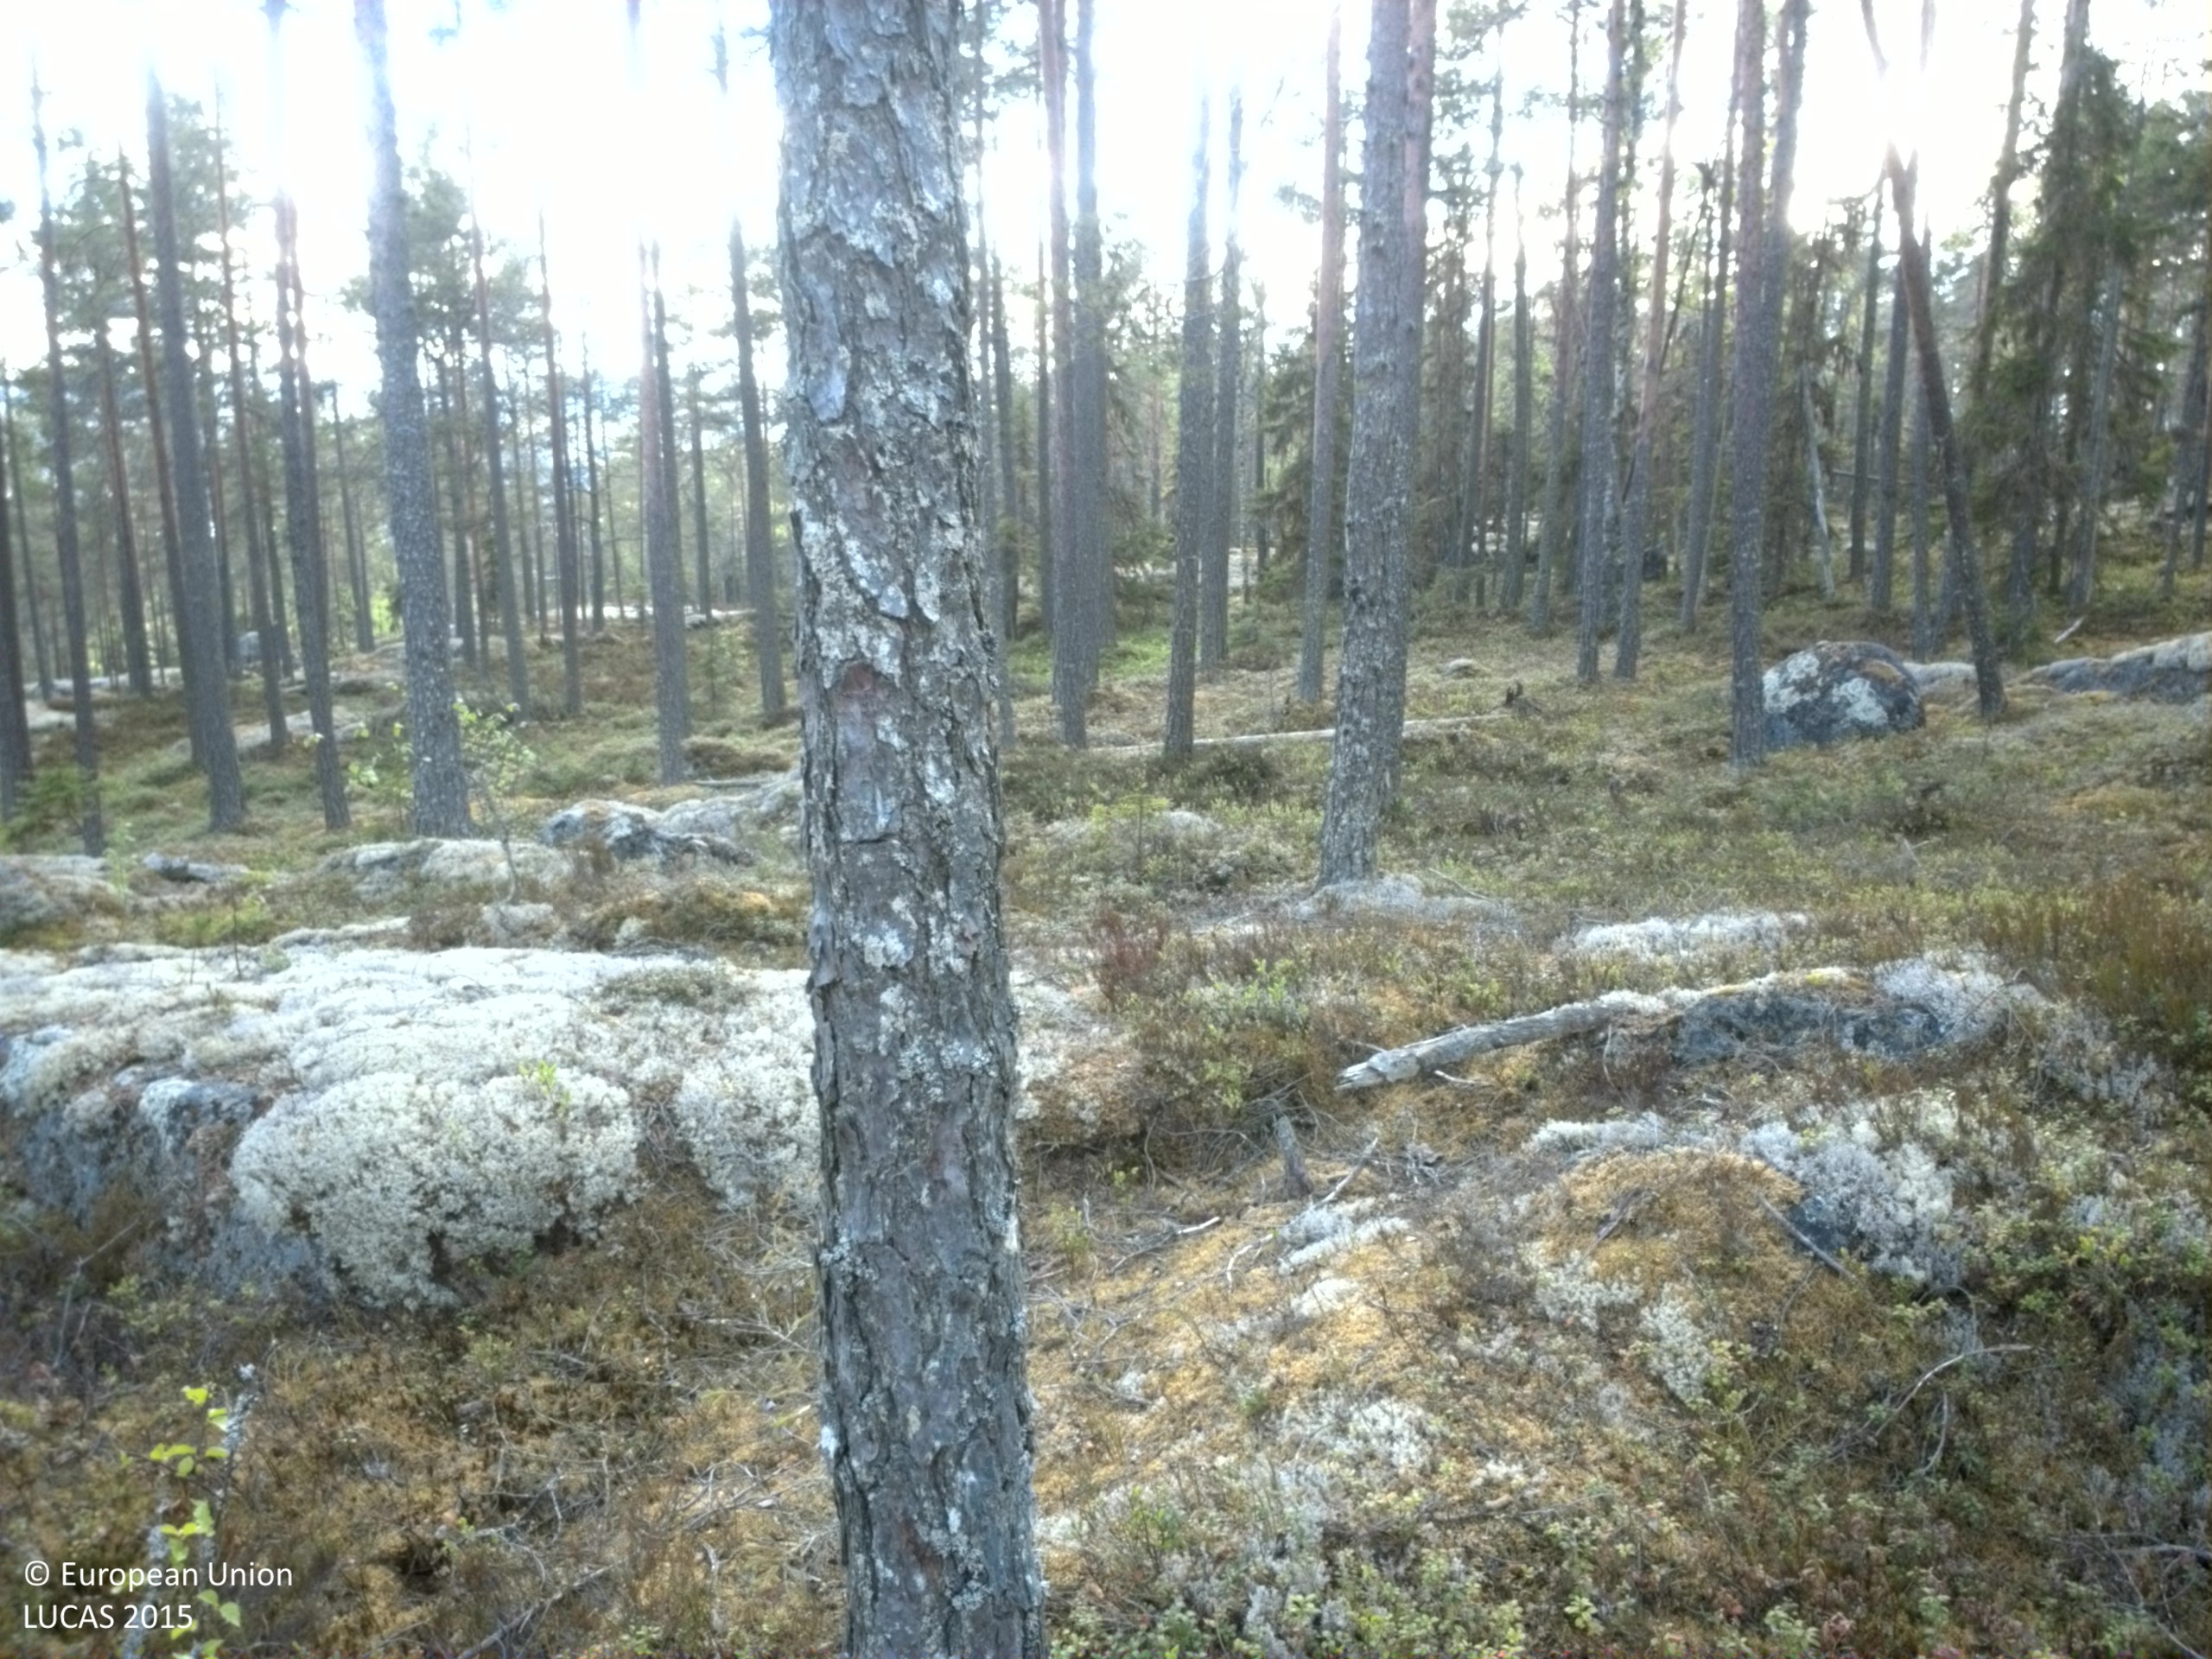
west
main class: Woodland
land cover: Pine dominated coniferous woodland
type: boreal forest
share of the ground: 25 - 50 %
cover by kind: coniferous forest trees 35 %, shrubs 30 %, lichens and mosses 30 %, consolidated bare surface 5 %
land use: Forestry
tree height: > 5 m
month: May
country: SE
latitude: 63.1170
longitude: 17.8070
